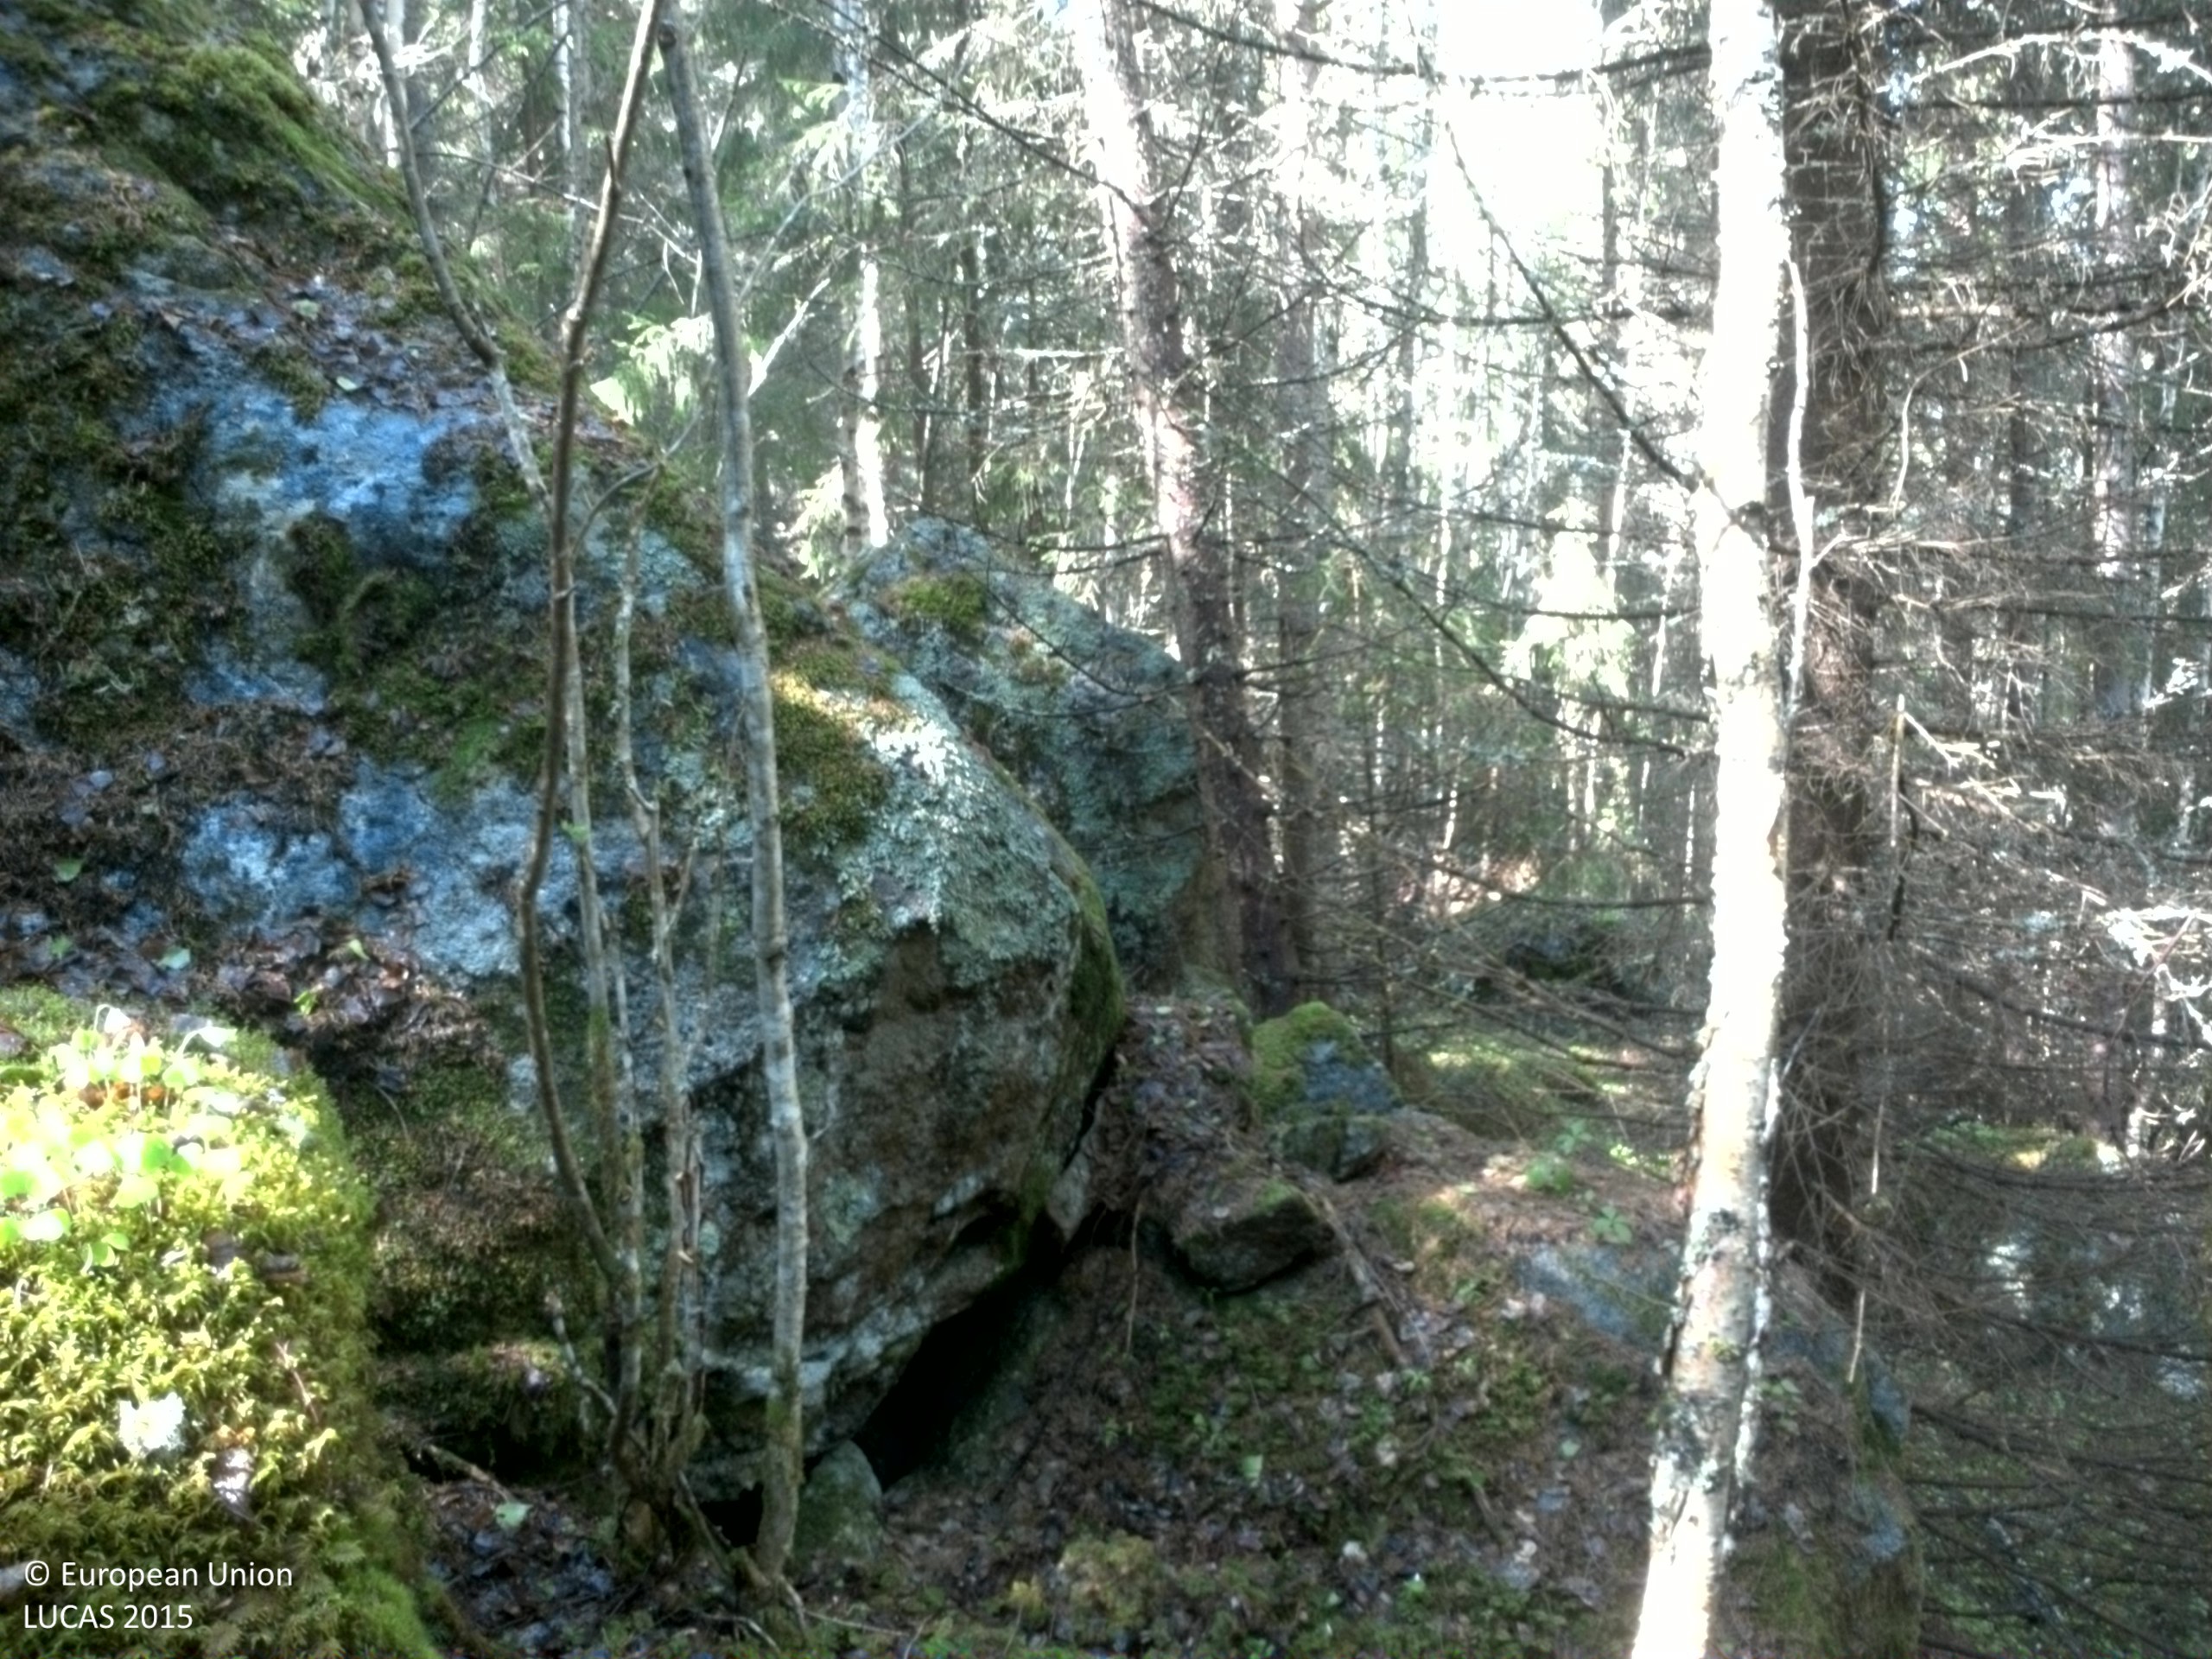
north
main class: Woodland
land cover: Spruce dominated coniferous woodland
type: boreal forest
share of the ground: > 75 %
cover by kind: coniferous forest trees 90 %, lichens and mosses 10 %
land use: Forestry
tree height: > 5 m
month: June
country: SE
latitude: 63.1229
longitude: 17.6894
